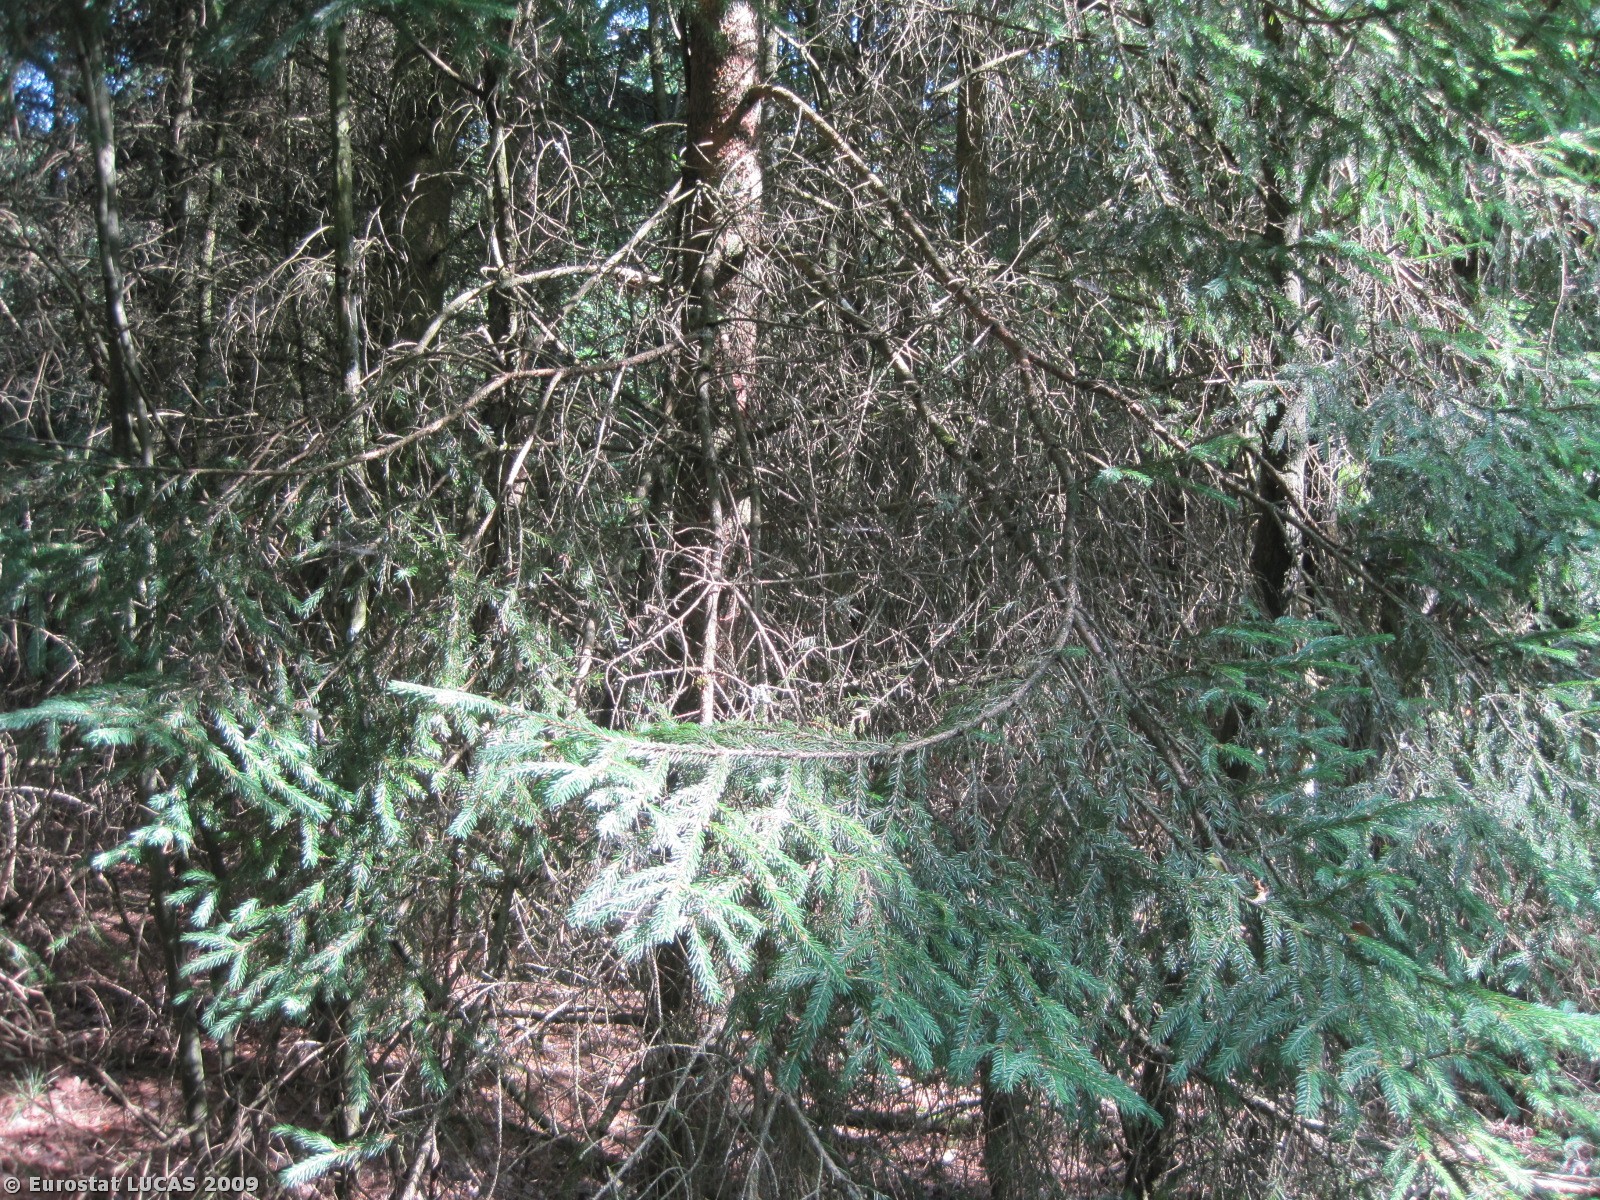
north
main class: Woodland
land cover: Mixed woodland
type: plantations and self-sown exotic forest
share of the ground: > 75 %
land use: Forestry
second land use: Amenities, museums, leisure
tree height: > 5 m
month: June
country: DK
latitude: 56.3085
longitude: 8.8537
